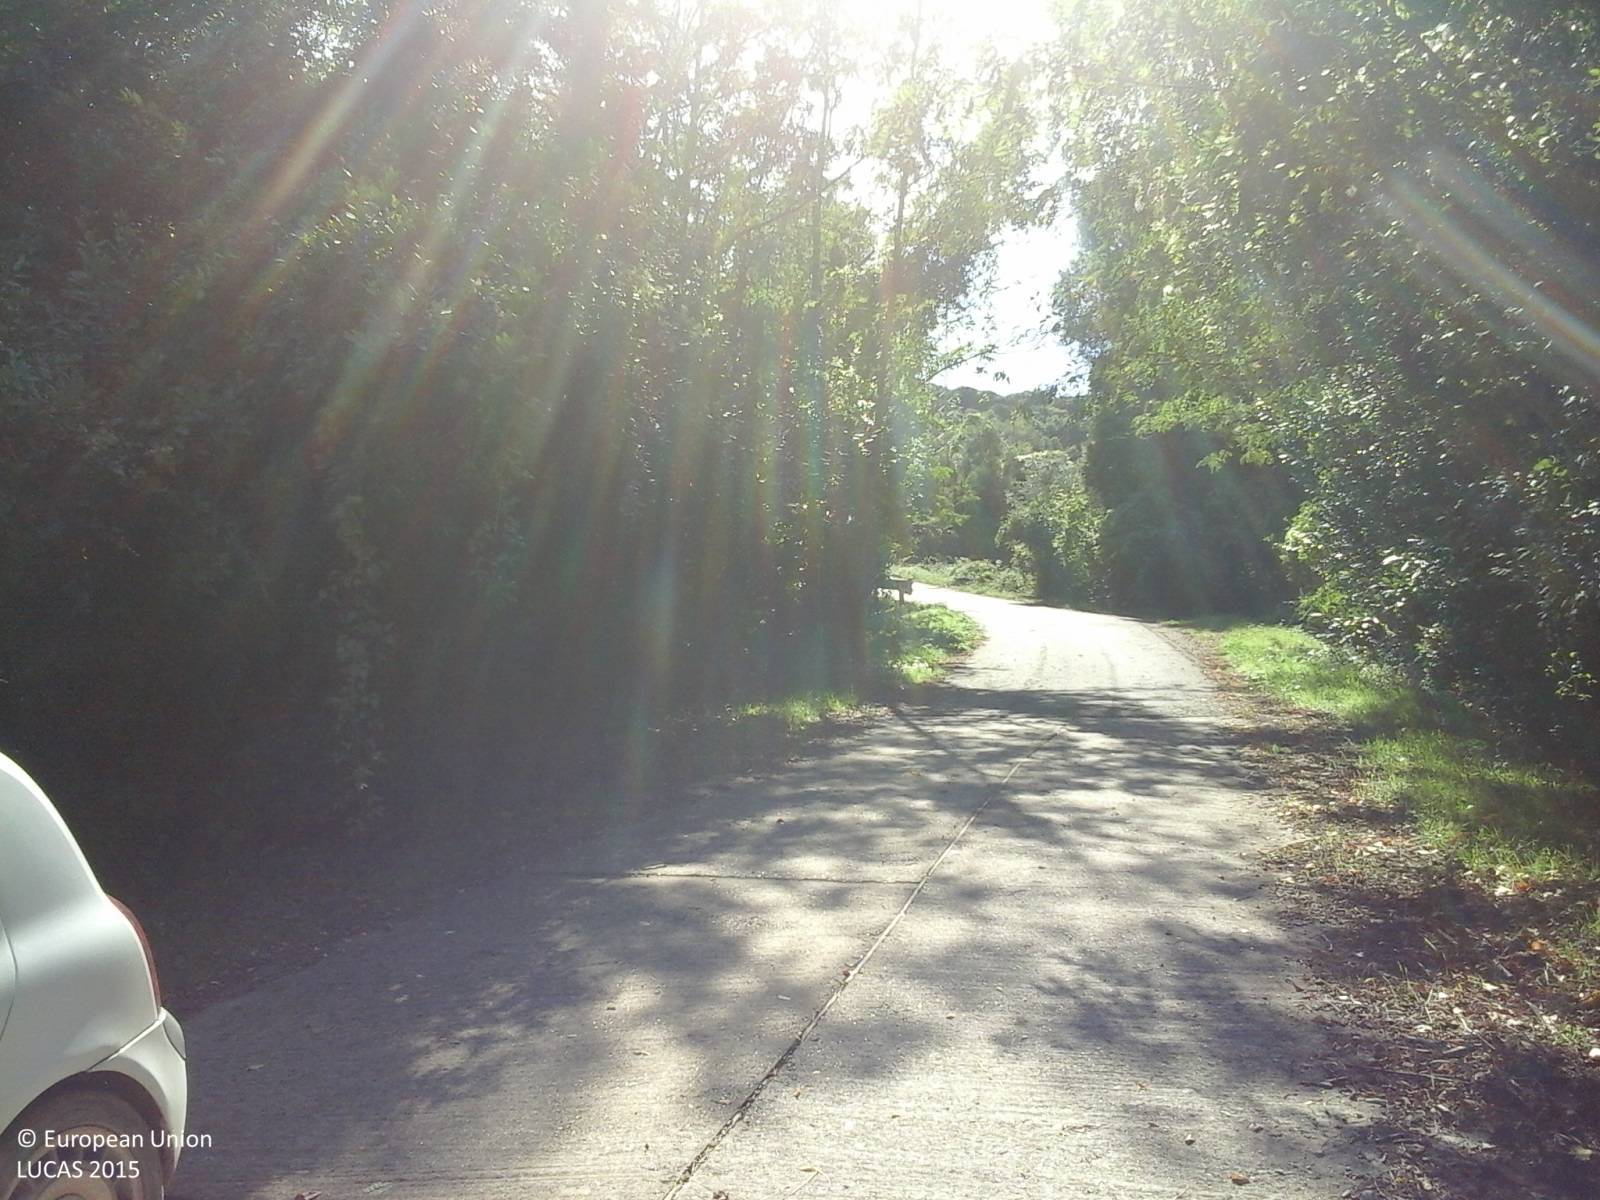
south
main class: Woodland
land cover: Broadleaved woodland
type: broadleaved evergreen forest
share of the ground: > 75 %
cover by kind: broadleaved forest trees 90 %, shrubs 10 %
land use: Semi-natural and natural areas not in use
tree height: > 5 m
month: October
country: IT
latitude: 40.2028
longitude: 8.5859
